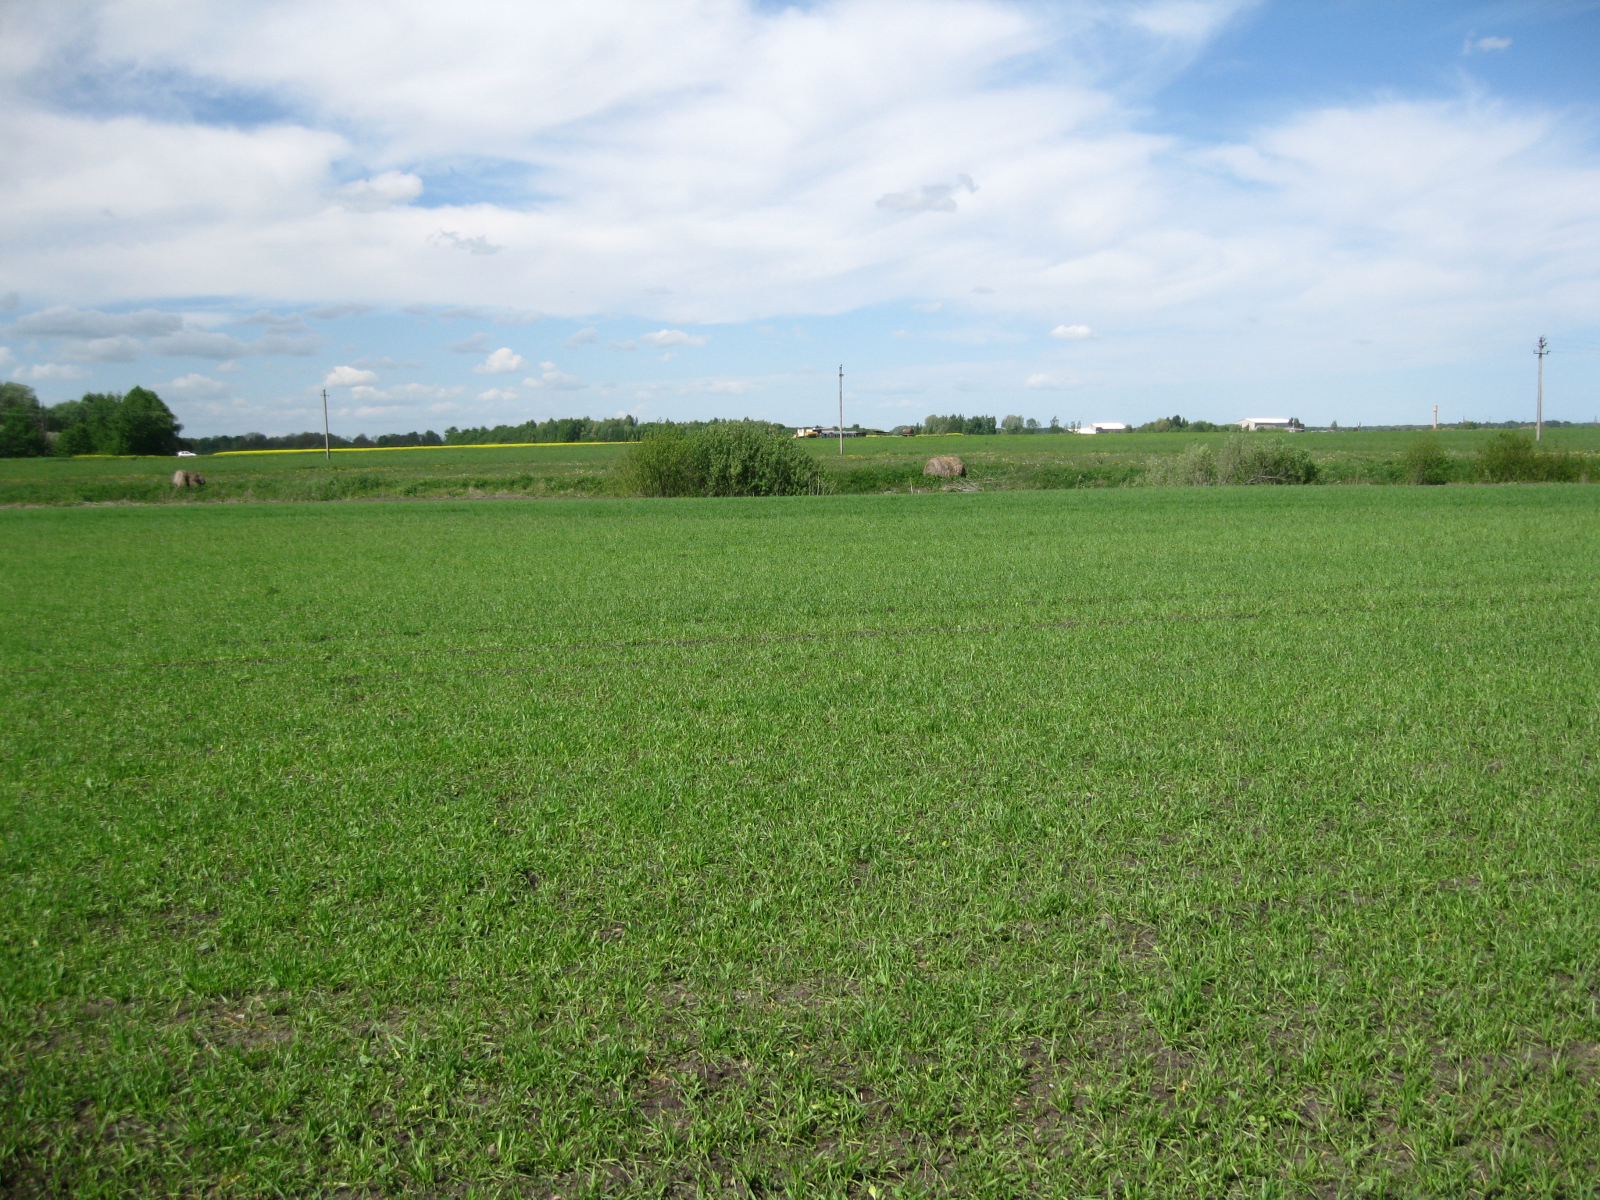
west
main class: Cropland
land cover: Barley
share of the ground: > 75 %
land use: Agriculture (excluding fallow land and kitchen gardens)
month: May
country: LT
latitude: 56.1488
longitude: 24.1421
